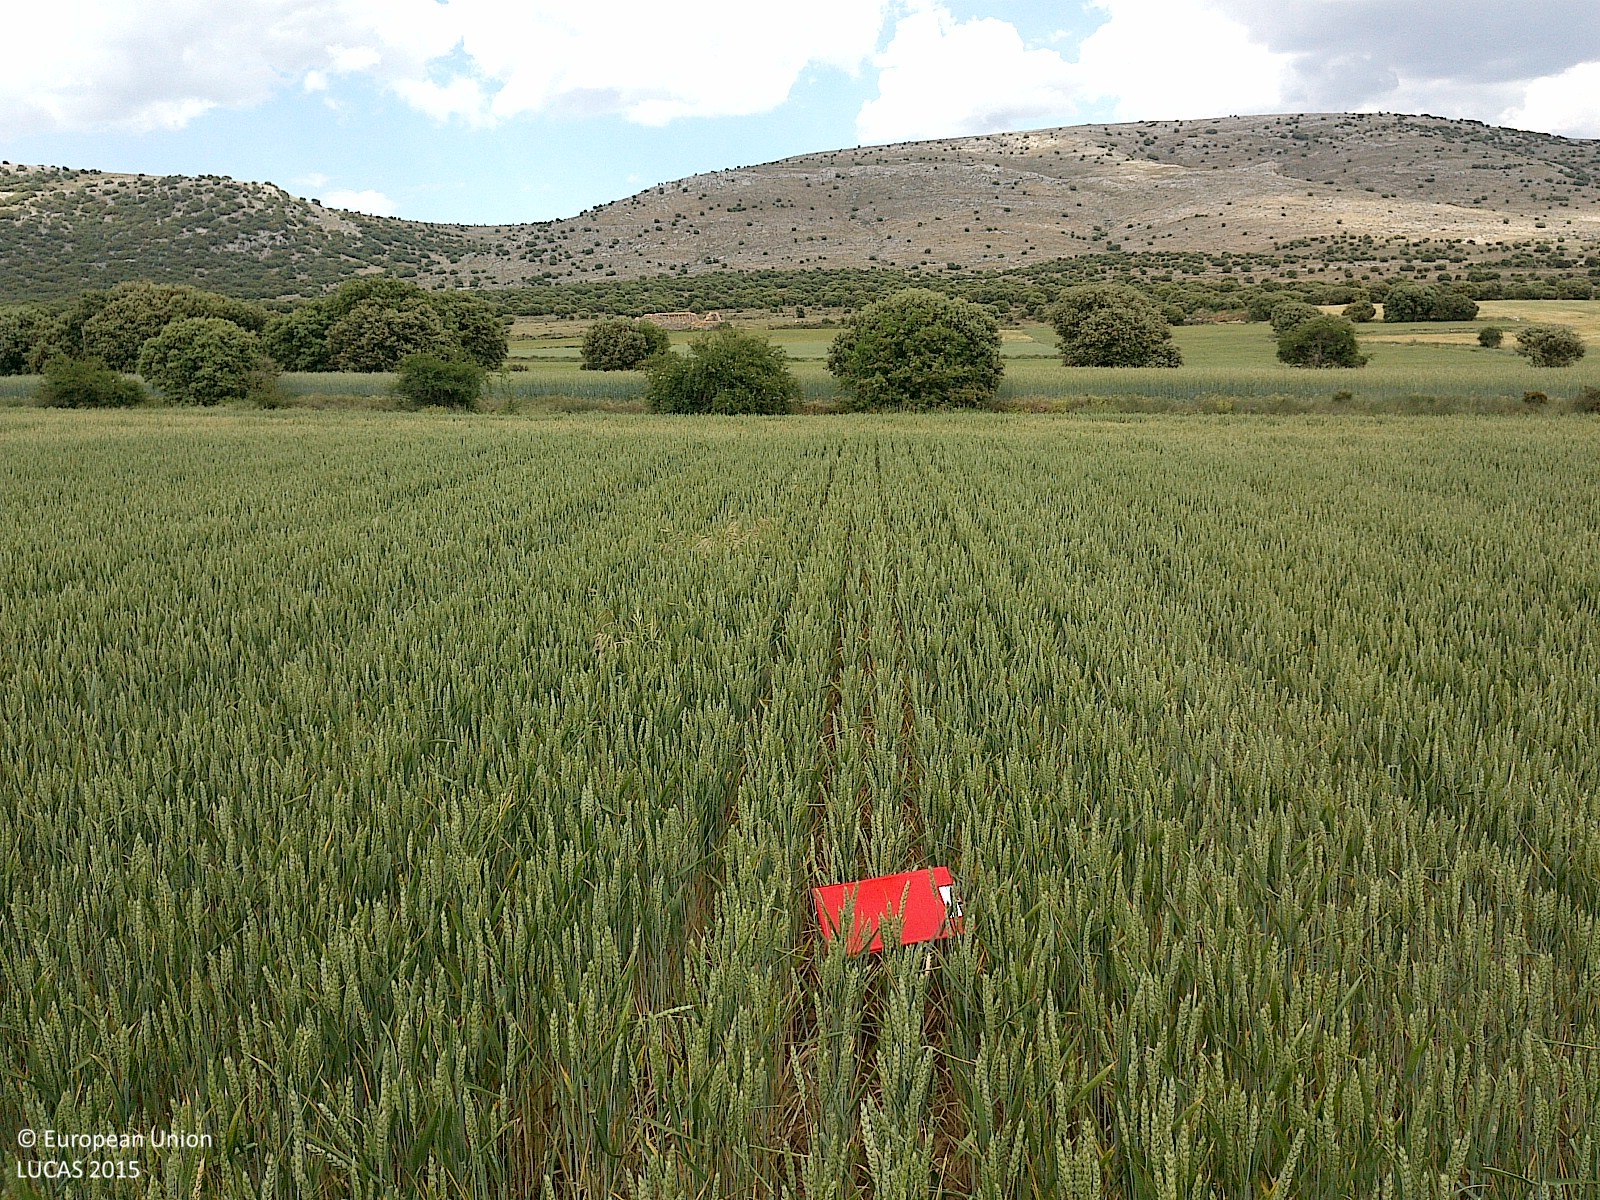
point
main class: Cropland
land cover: Common wheat
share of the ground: > 75 %
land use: Agriculture (excluding fallow land and kitchen gardens)
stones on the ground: < 10 %
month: June
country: ES
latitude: 41.7324
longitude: -2.1894
